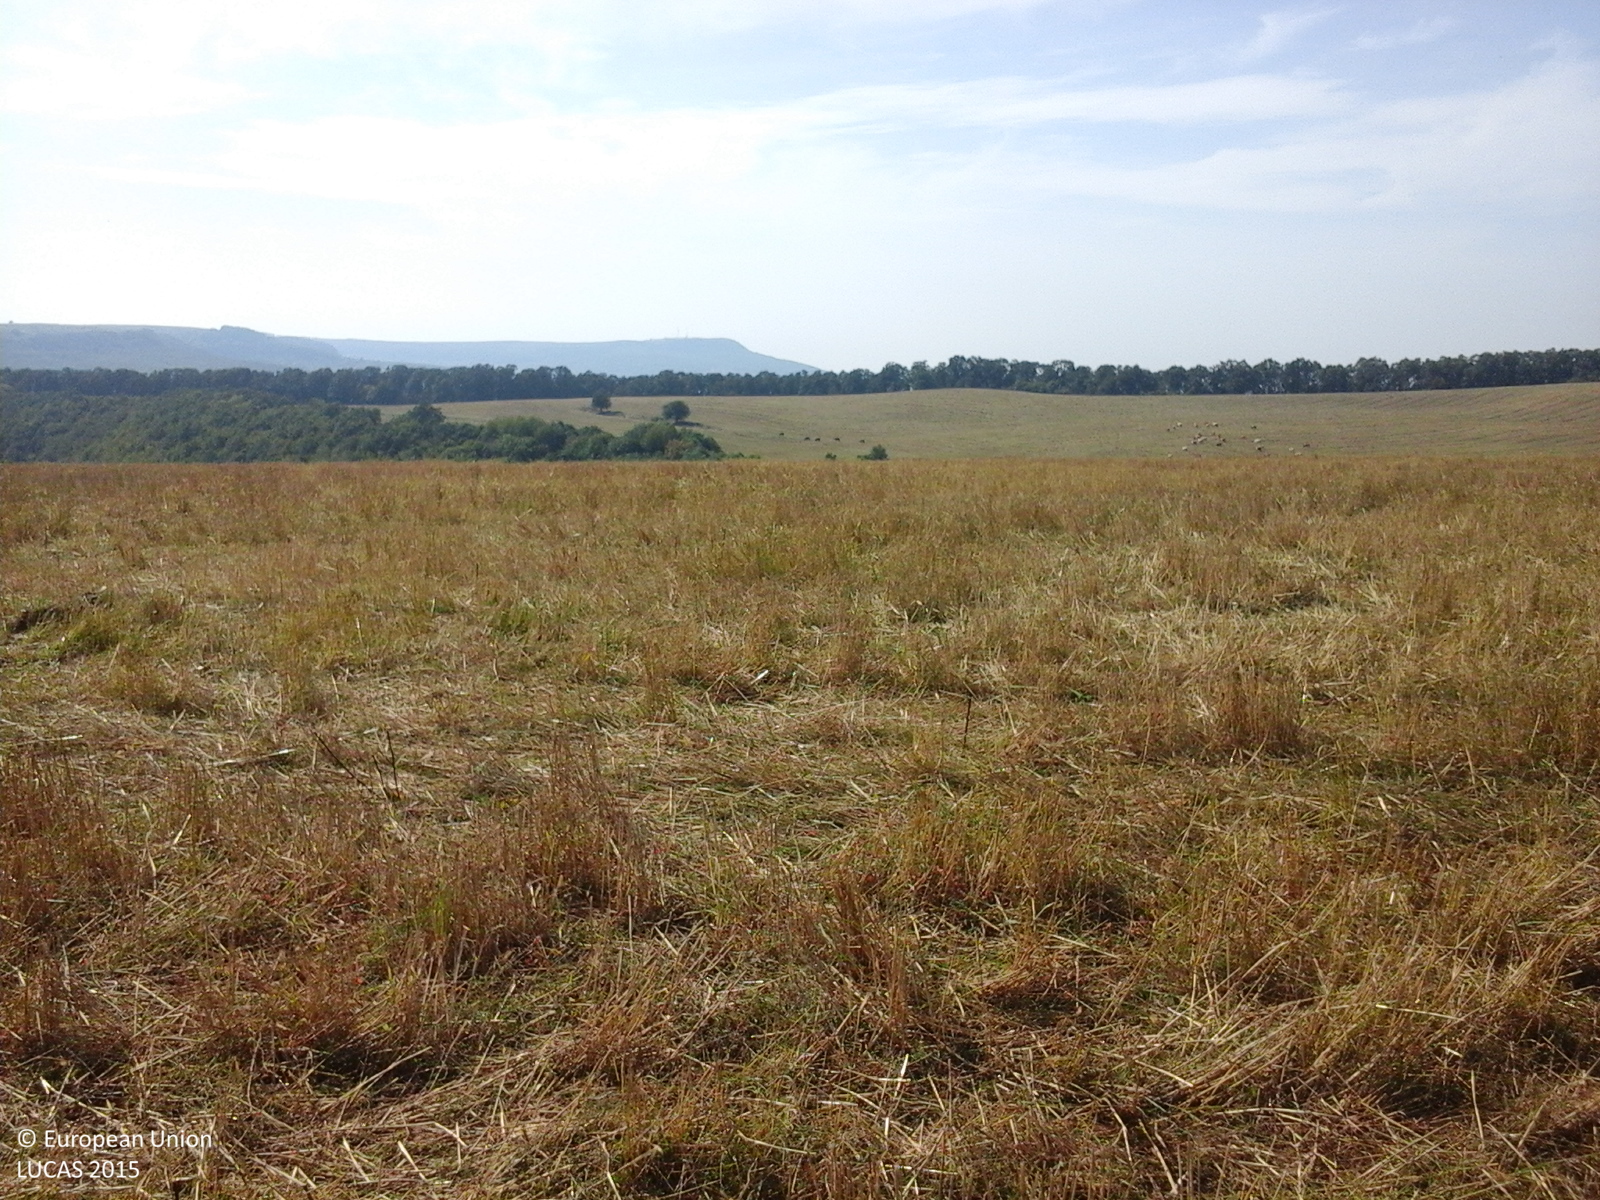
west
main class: Cropland
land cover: Common wheat
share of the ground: > 75 %
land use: Agriculture (excluding fallow land and kitchen gardens)
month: September
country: RO
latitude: 47.1203
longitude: 23.7444
